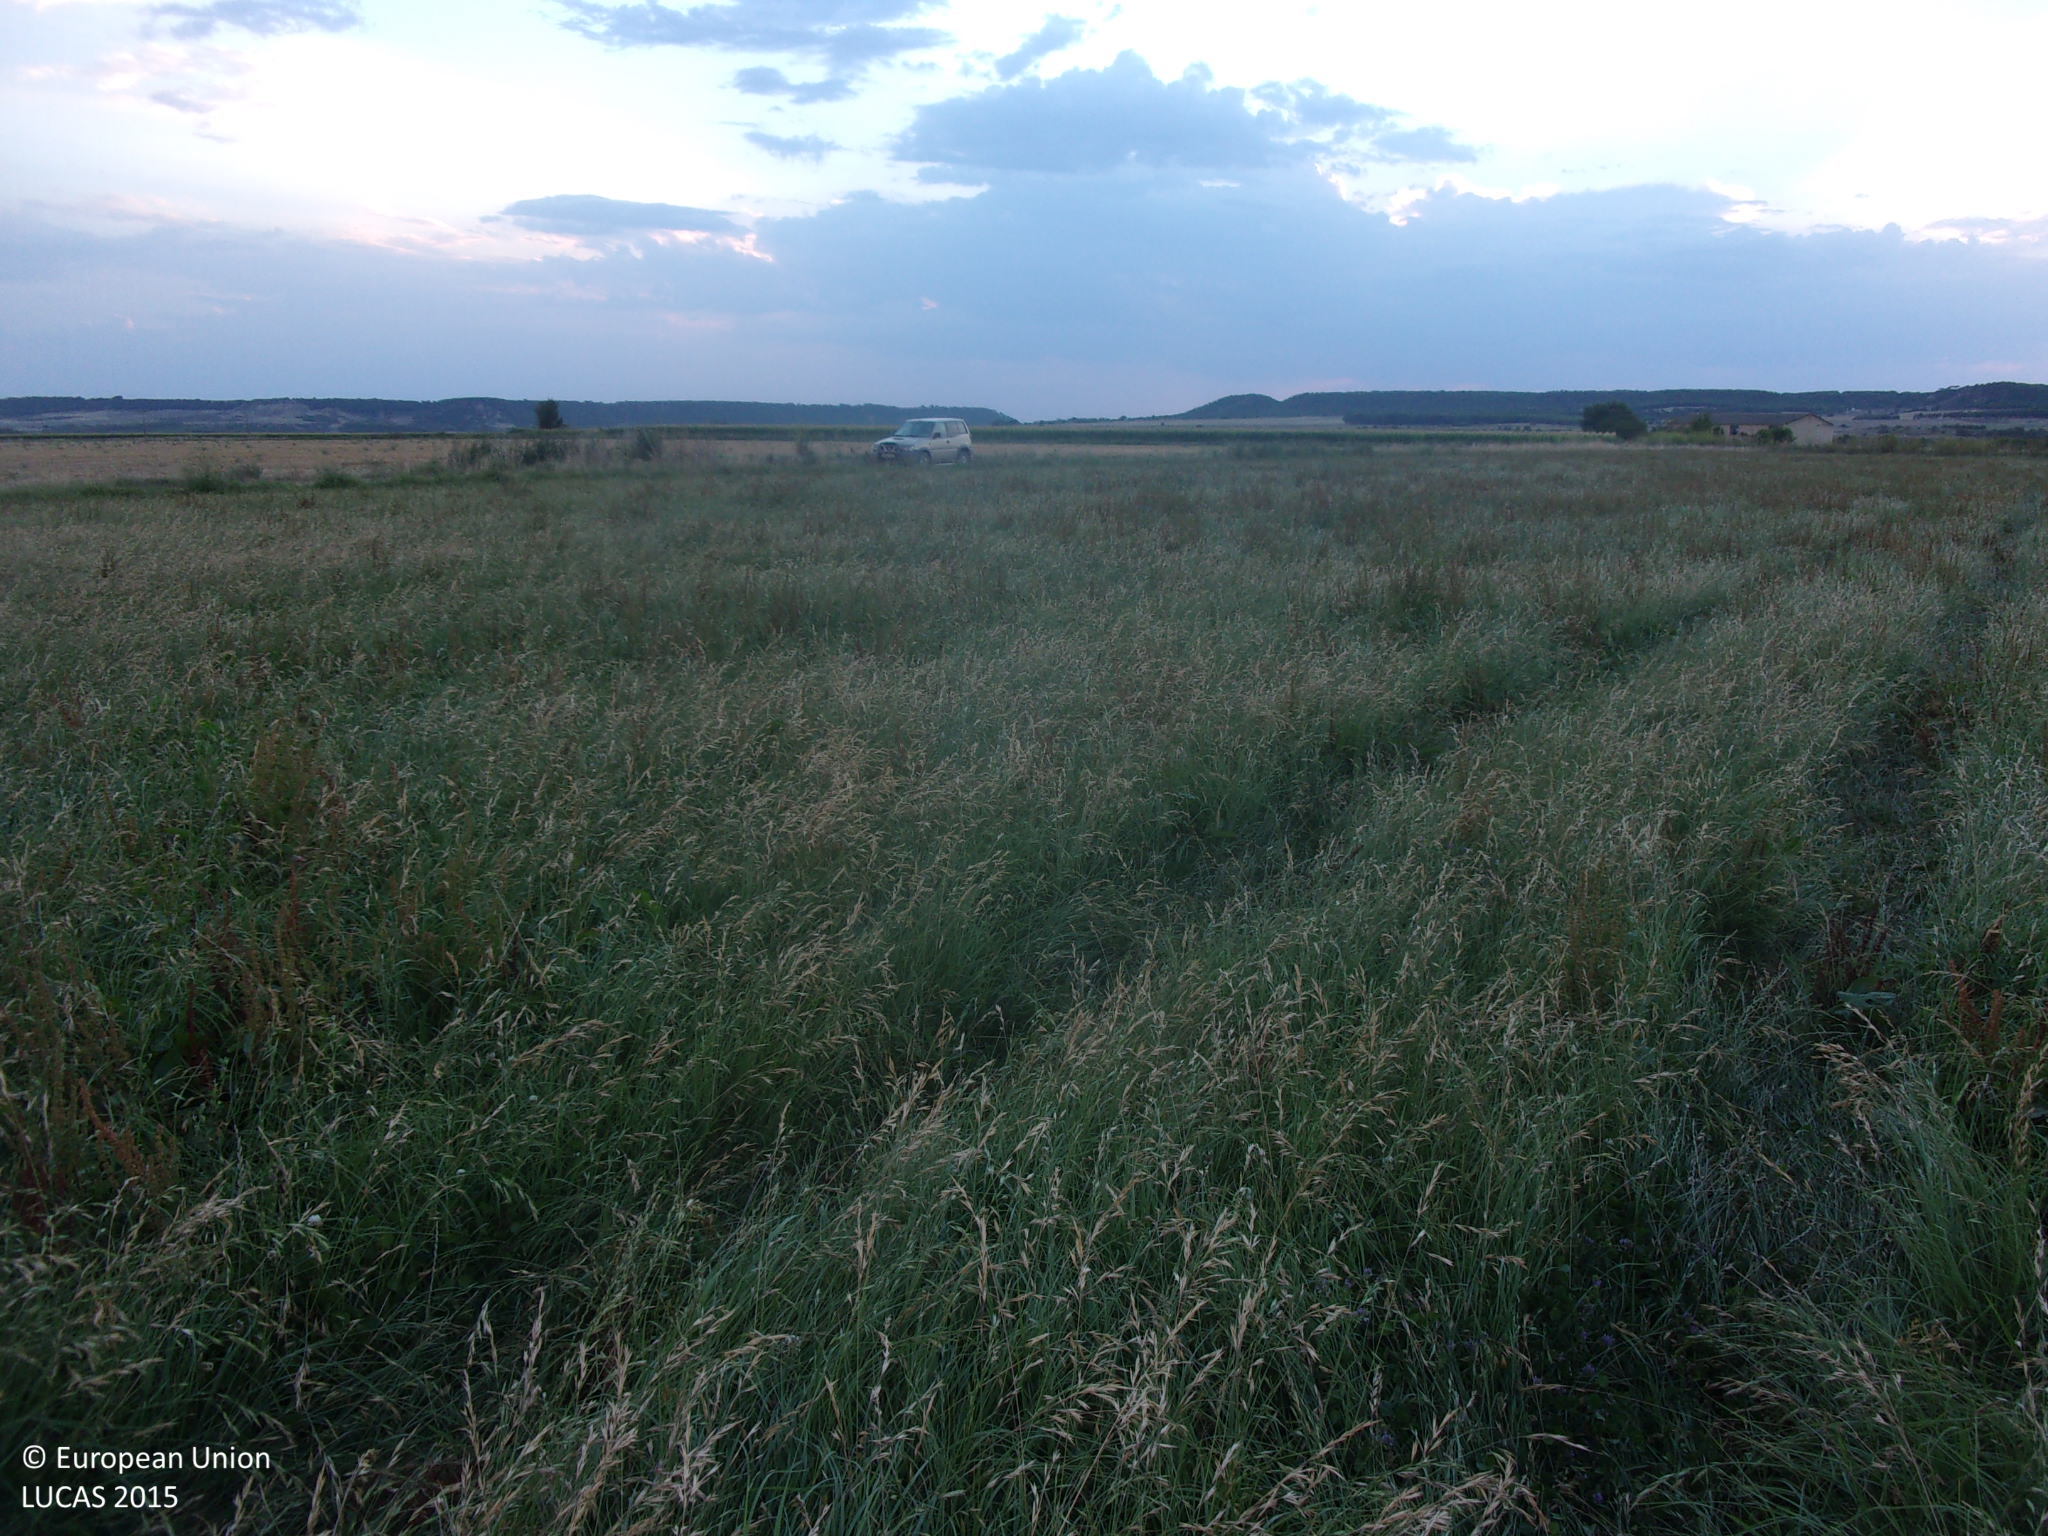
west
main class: Cropland
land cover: Temporary grasslands
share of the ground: > 75 %
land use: Agriculture (excluding fallow land and kitchen gardens)
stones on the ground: < 10 %
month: August
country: ES
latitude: 42.3562
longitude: -1.3840
